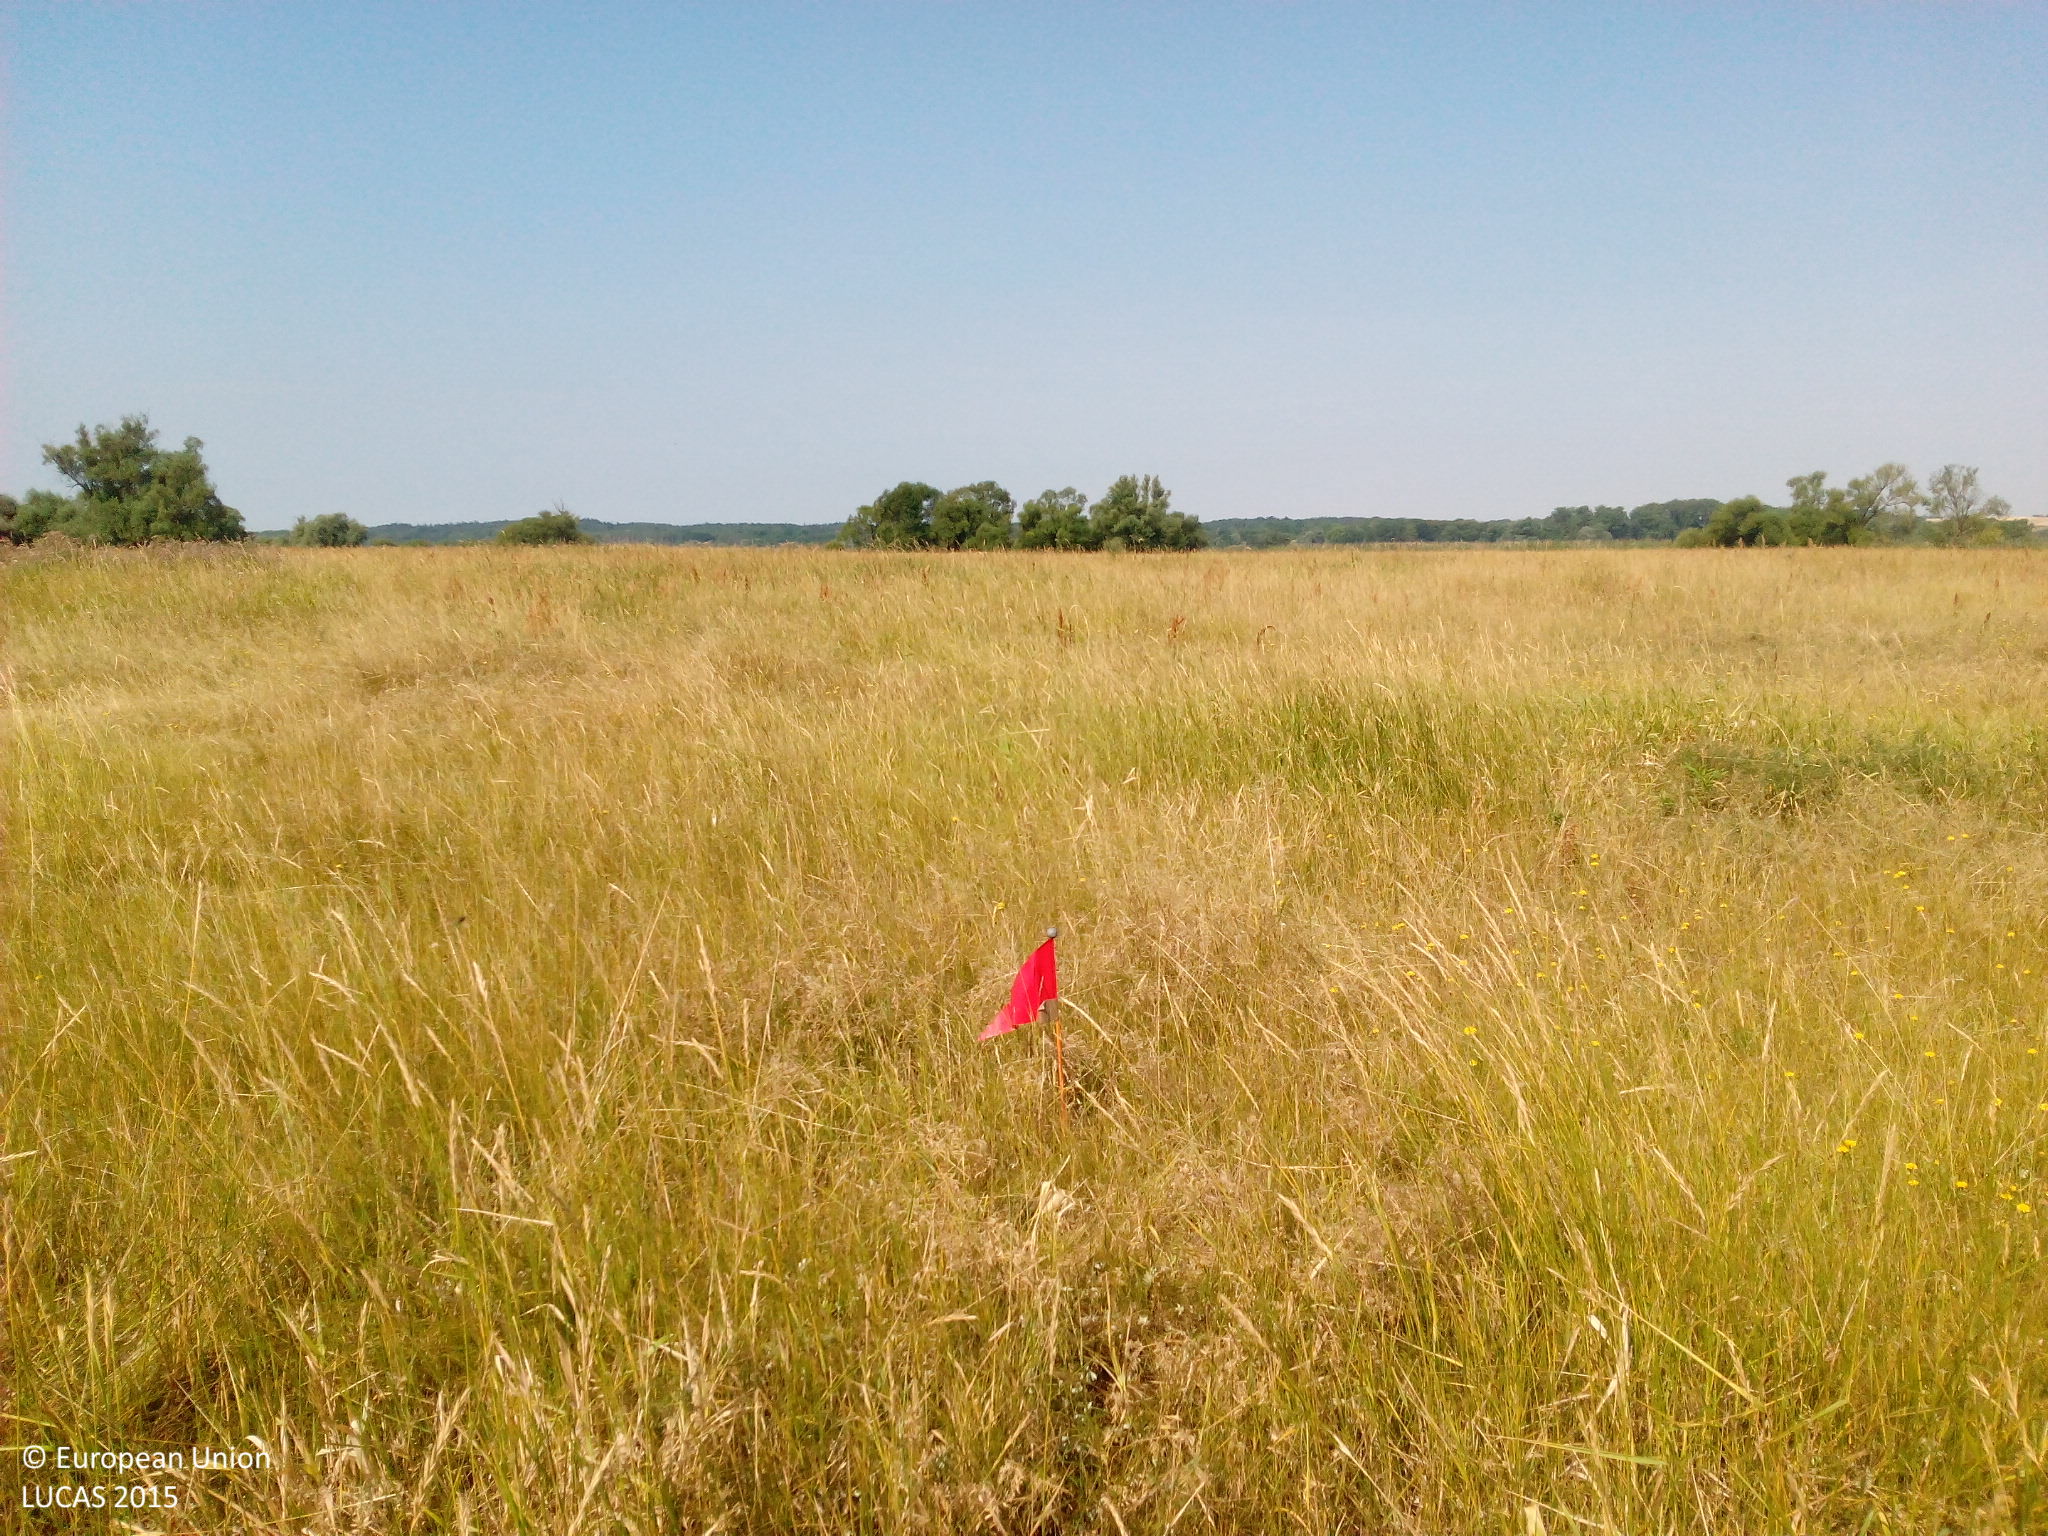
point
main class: Grassland
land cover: Grassland without tree/shrub cover
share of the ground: > 75 %
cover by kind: herbaceous plants 100 %
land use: Semi-natural and natural areas not in use
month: August
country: DE
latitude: 53.0035
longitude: 14.2479
